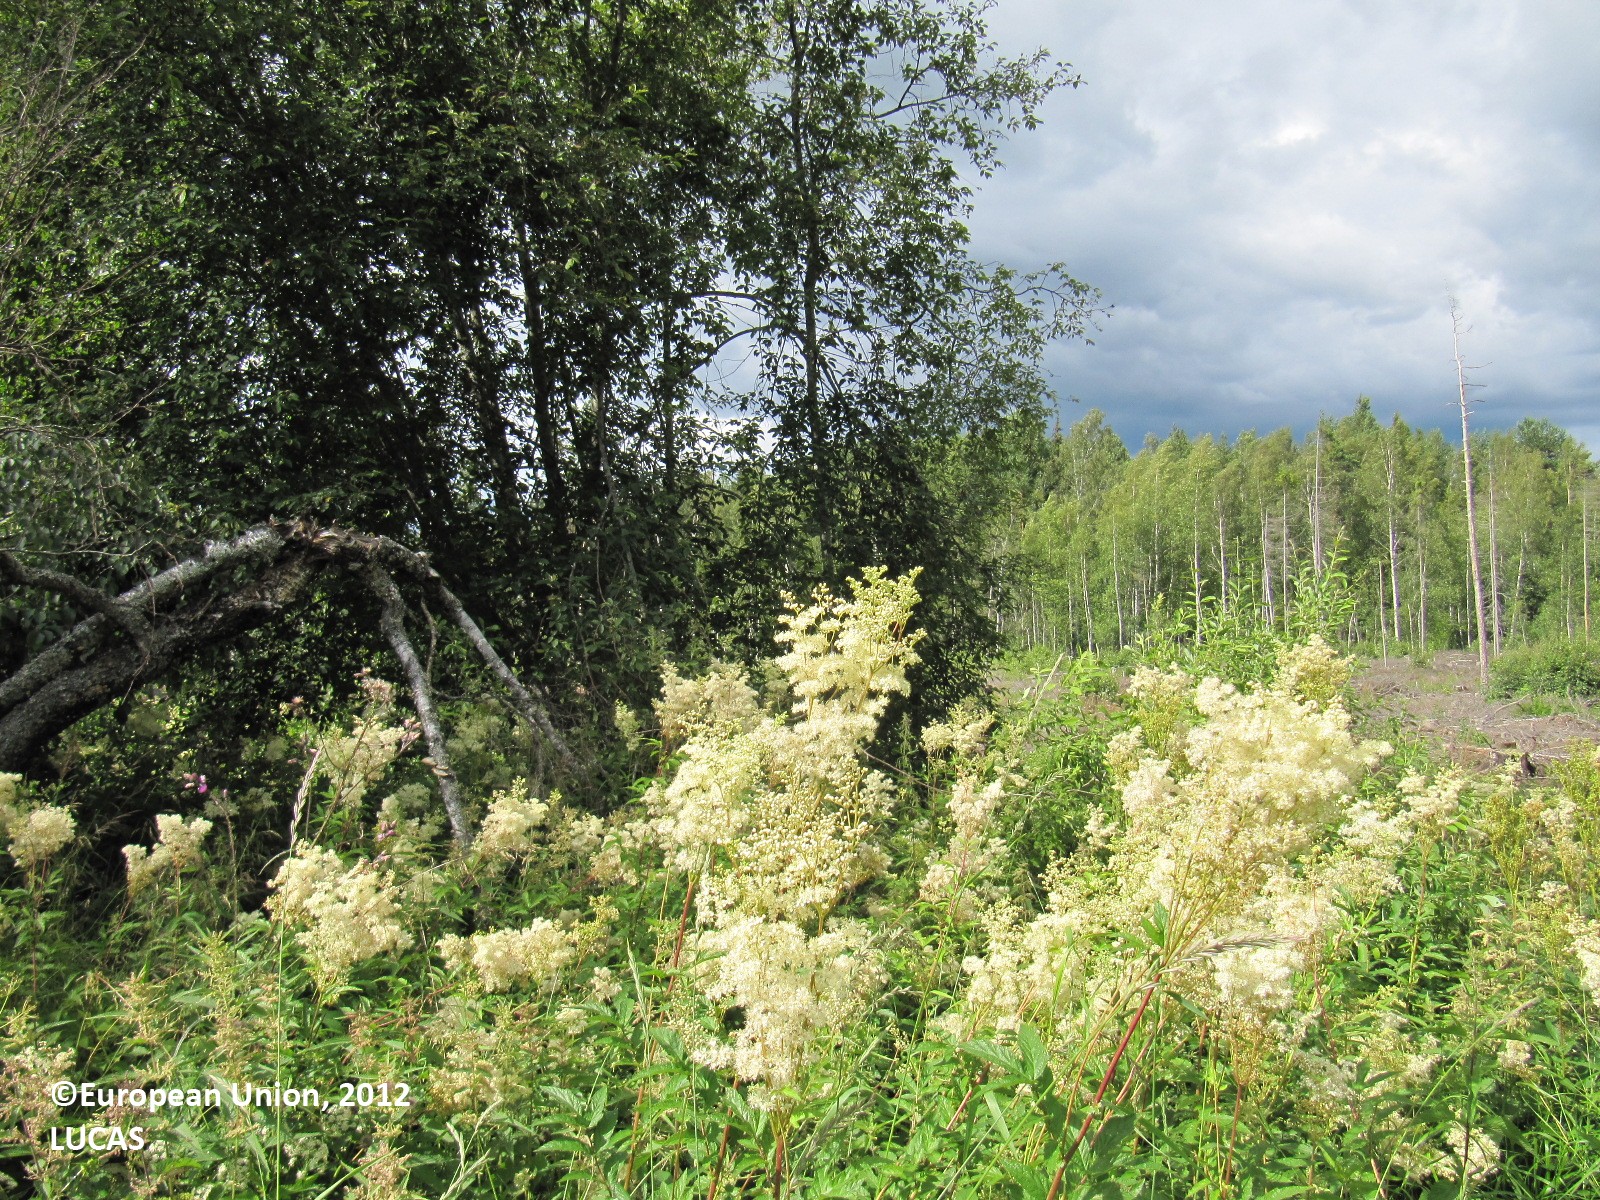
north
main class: Shrubland
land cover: Shrubland with sparse tree cover
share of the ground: 25 - 50 %
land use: Forestry
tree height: < 5 m
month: July
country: FI
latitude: 61.1053
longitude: 24.5930
